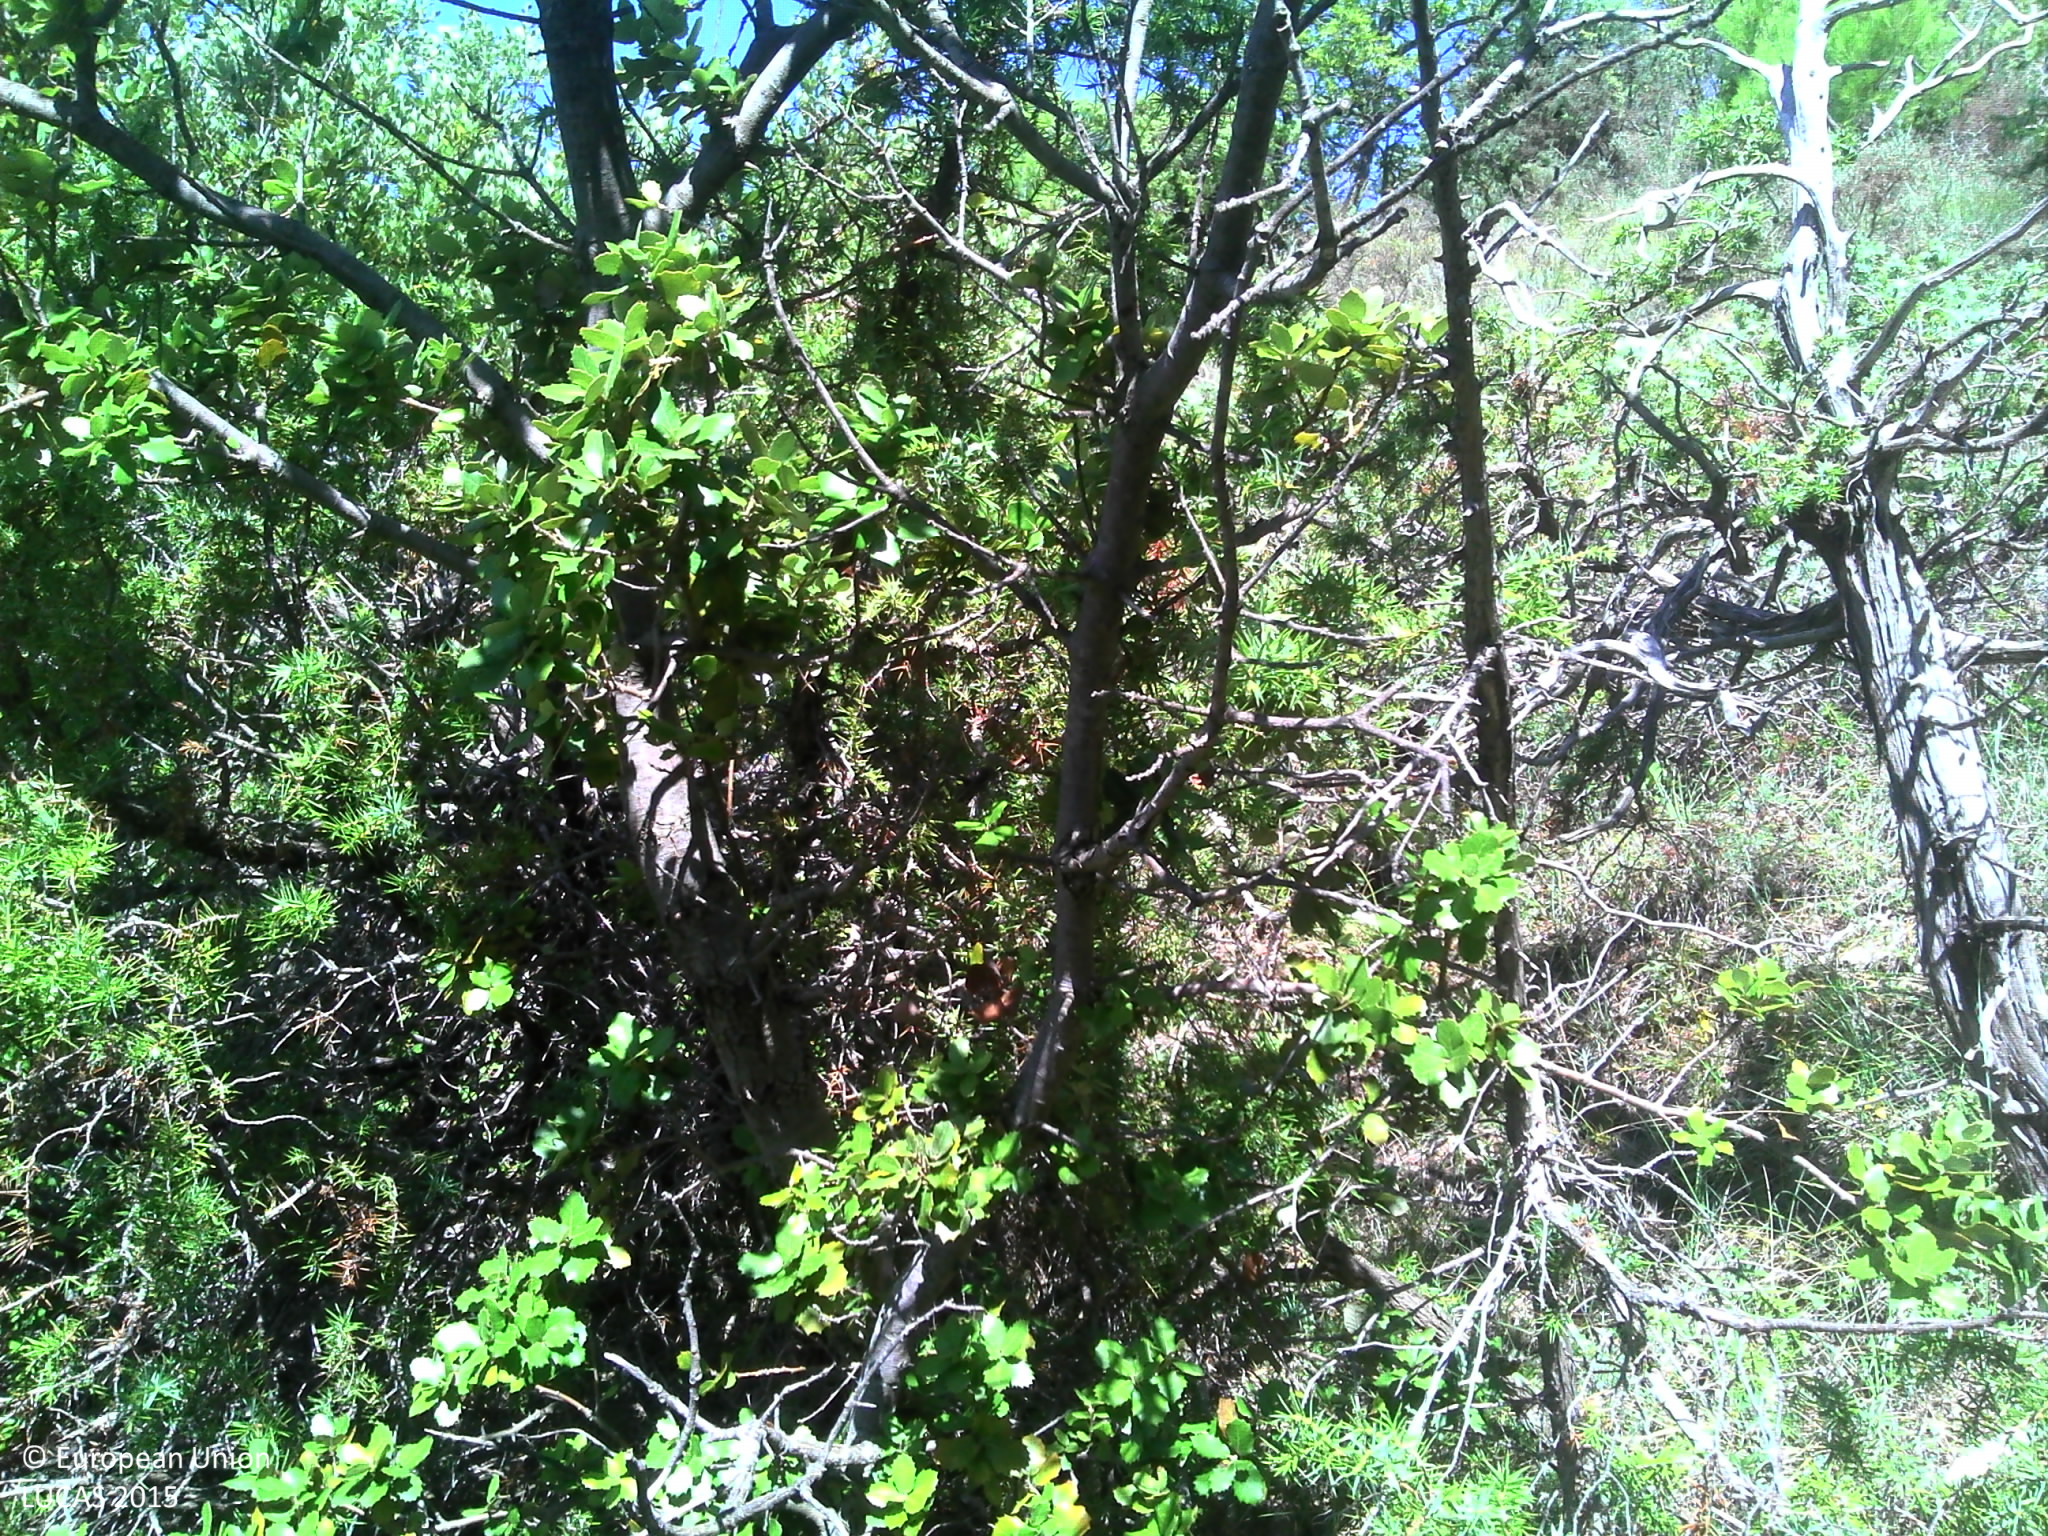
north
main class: Woodland
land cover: Pine dominated mixed woodland
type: coniferous forest of the mediterranean region
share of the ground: 50 - 75 %
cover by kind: shrubs 55 %, broadleaved forest trees 25 %, coniferous forest trees 20 %
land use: Agriculture (excluding fallow land and kitchen gardens)
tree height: < 5 m
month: September
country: FR
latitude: 44.2098
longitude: 5.3397
